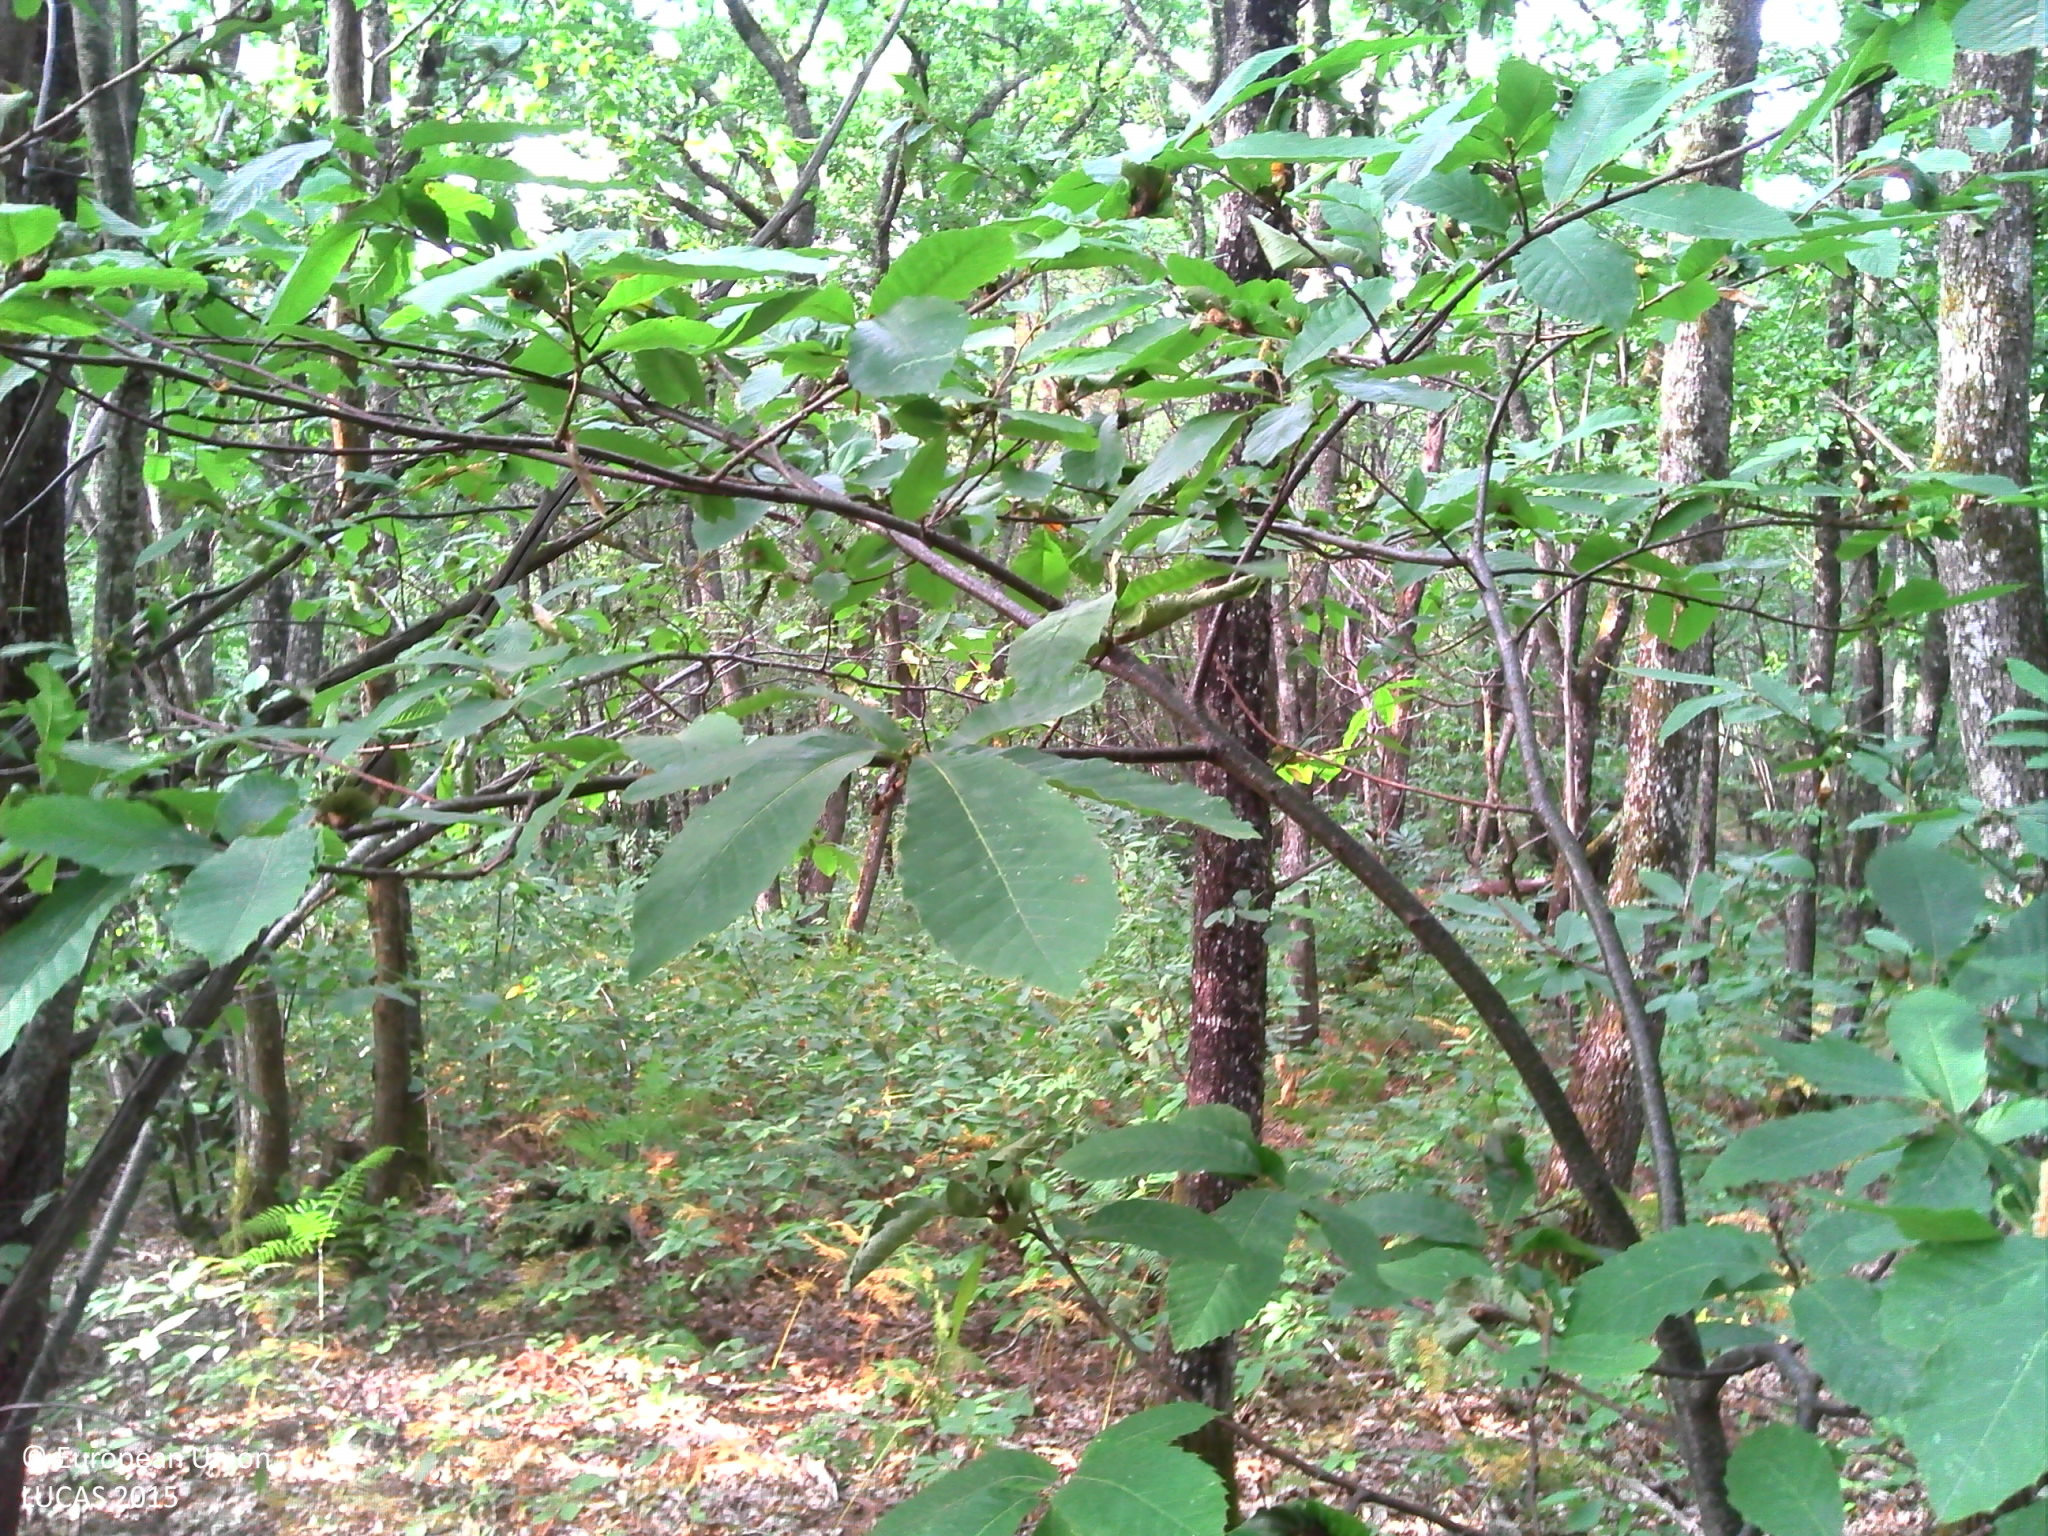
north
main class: Woodland
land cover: Broadleaved woodland
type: thermophilous deciduous forest
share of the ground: > 75 %
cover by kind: broadleaved forest trees 80 %, shrubs 10 %, herbaceous plants 5 %, lichens and mosses 5 %
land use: Forestry
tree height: > 5 m
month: July
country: FR
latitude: 45.0262
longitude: 0.5599
